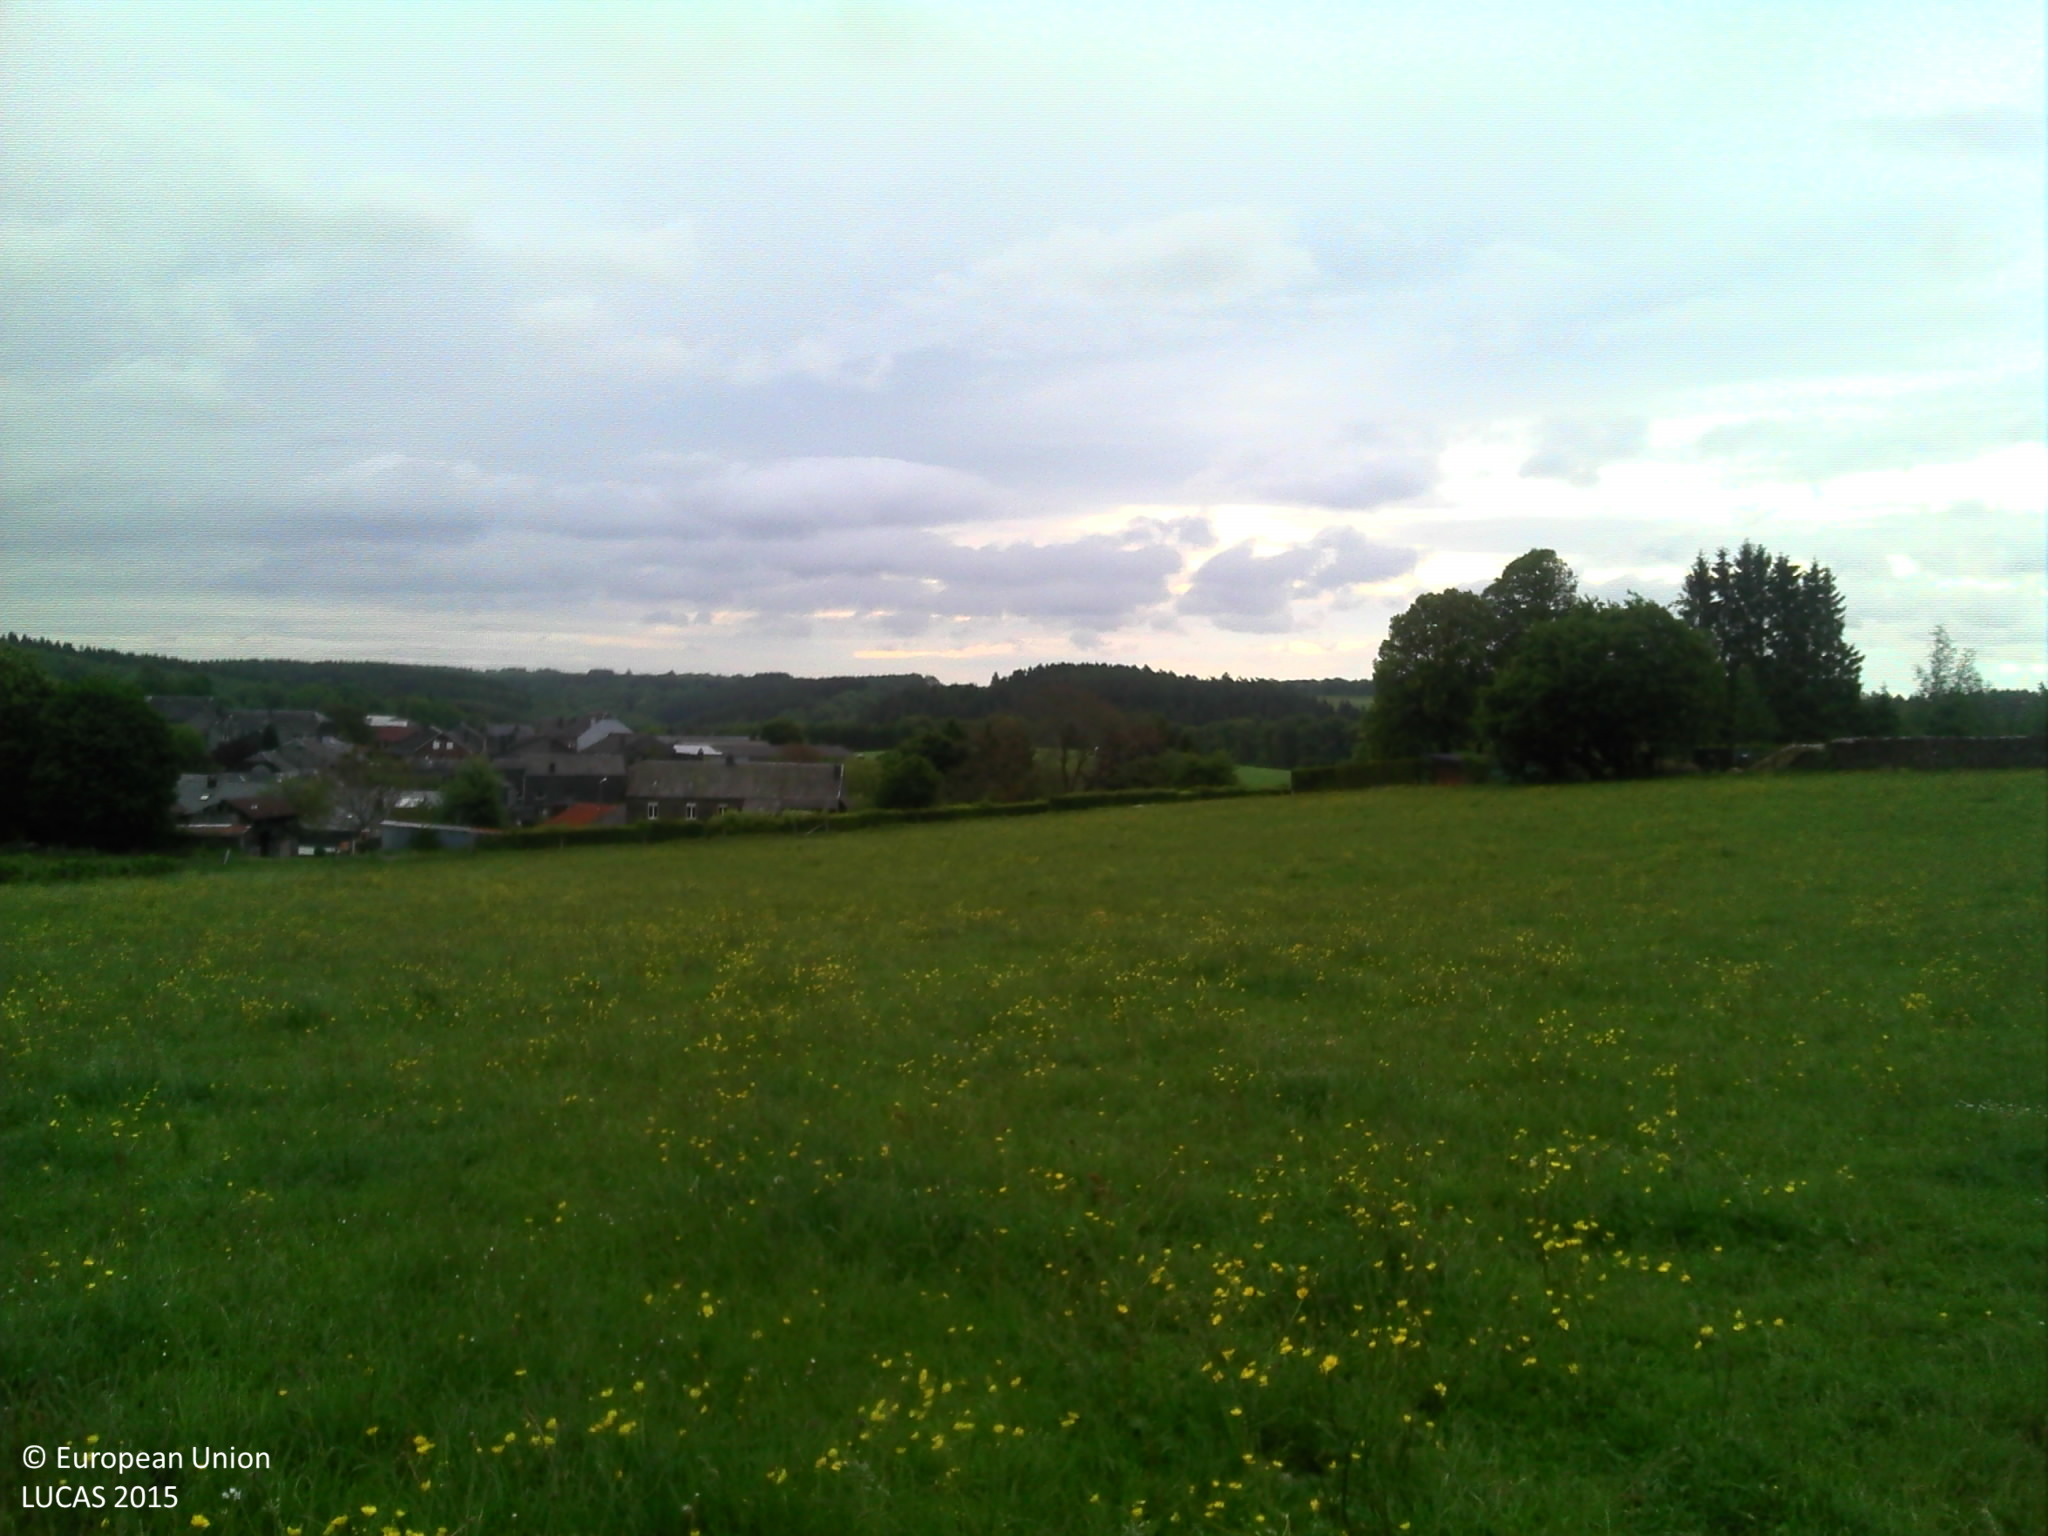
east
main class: Grassland
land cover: Grassland without tree/shrub cover
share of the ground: > 75 %
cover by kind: herbaceous plants 100 %
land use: Agriculture (excluding fallow land and kitchen gardens)
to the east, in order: Grassland without tree/shrub cover; Artificial constructions in urban areas; Spontaneously vegetated surfaces; Grassland without tree/shrub cover
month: June
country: BE
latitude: 49.9087
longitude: 4.9146
